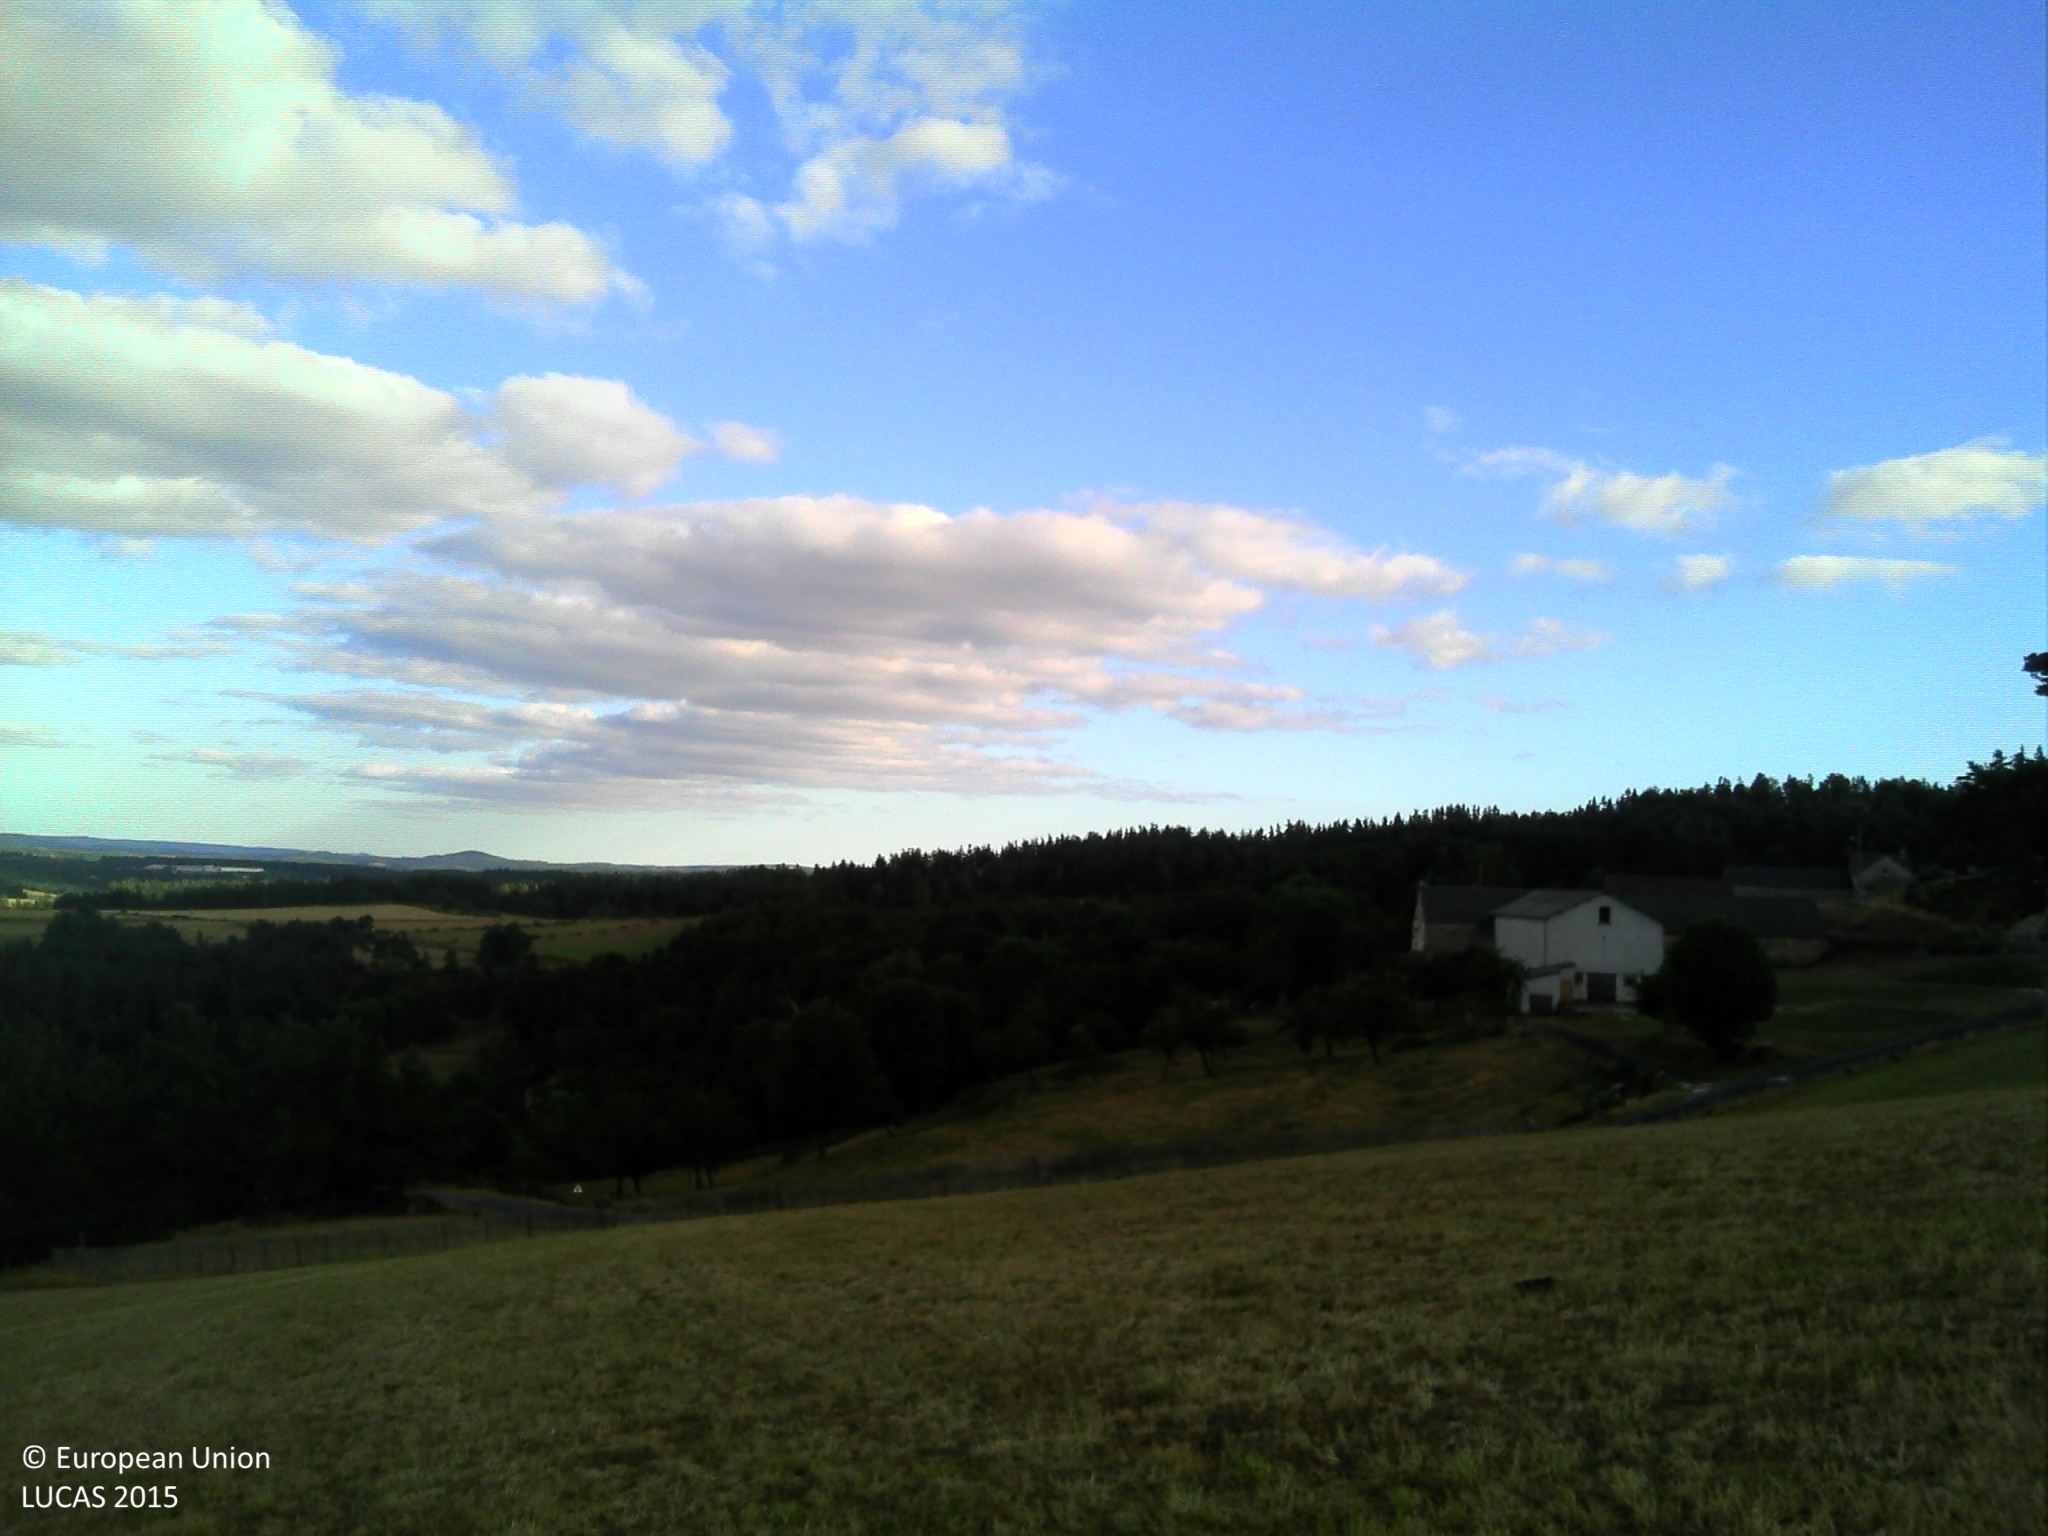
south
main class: Grassland
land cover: Grassland without tree/shrub cover
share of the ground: > 75 %
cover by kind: herbaceous plants 100 %
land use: Agriculture (excluding fallow land and kitchen gardens)
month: July
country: FR
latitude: 44.7456
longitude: 3.2467
